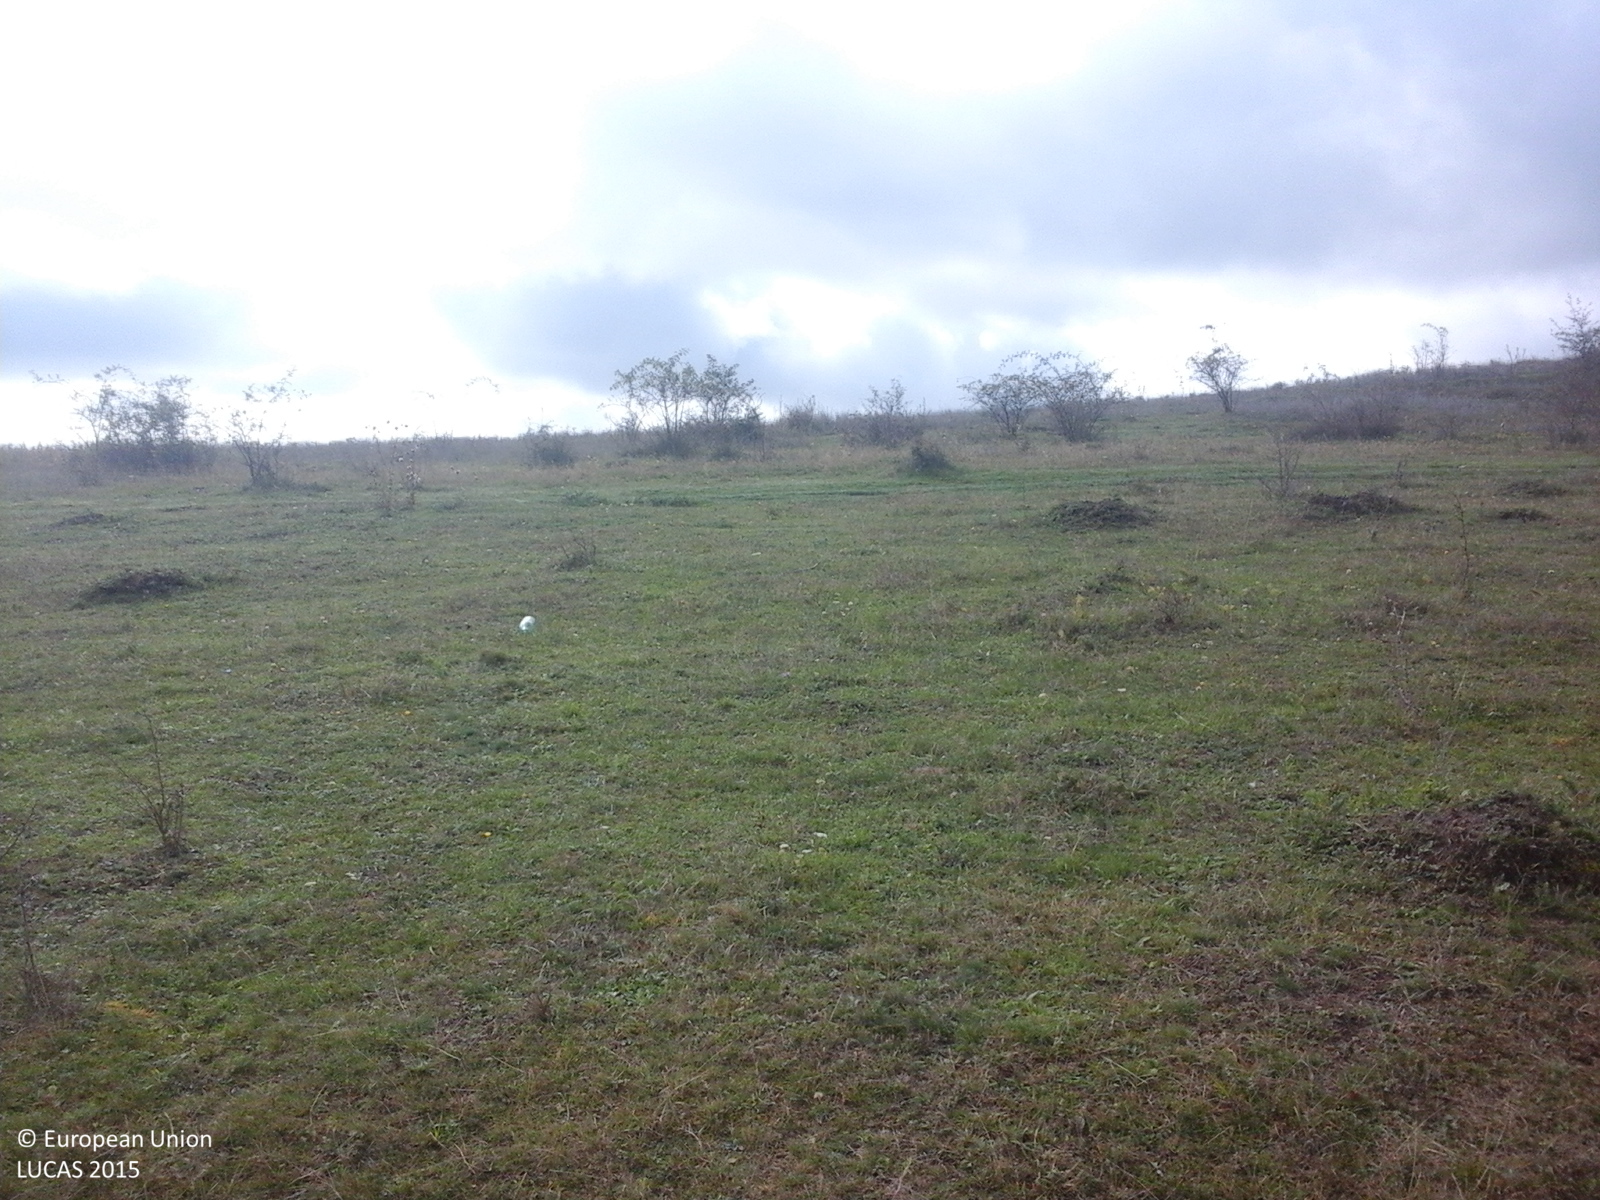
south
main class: Grassland
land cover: Grassland with sparse tree/shrub cover
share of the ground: > 75 %
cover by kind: herbaceous plants 95 %, broadleaved forest trees 5 %
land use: Agriculture (excluding fallow land and kitchen gardens)
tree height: < 5 m
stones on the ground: < 10 %
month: October
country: RO
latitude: 46.3783
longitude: 23.9740
